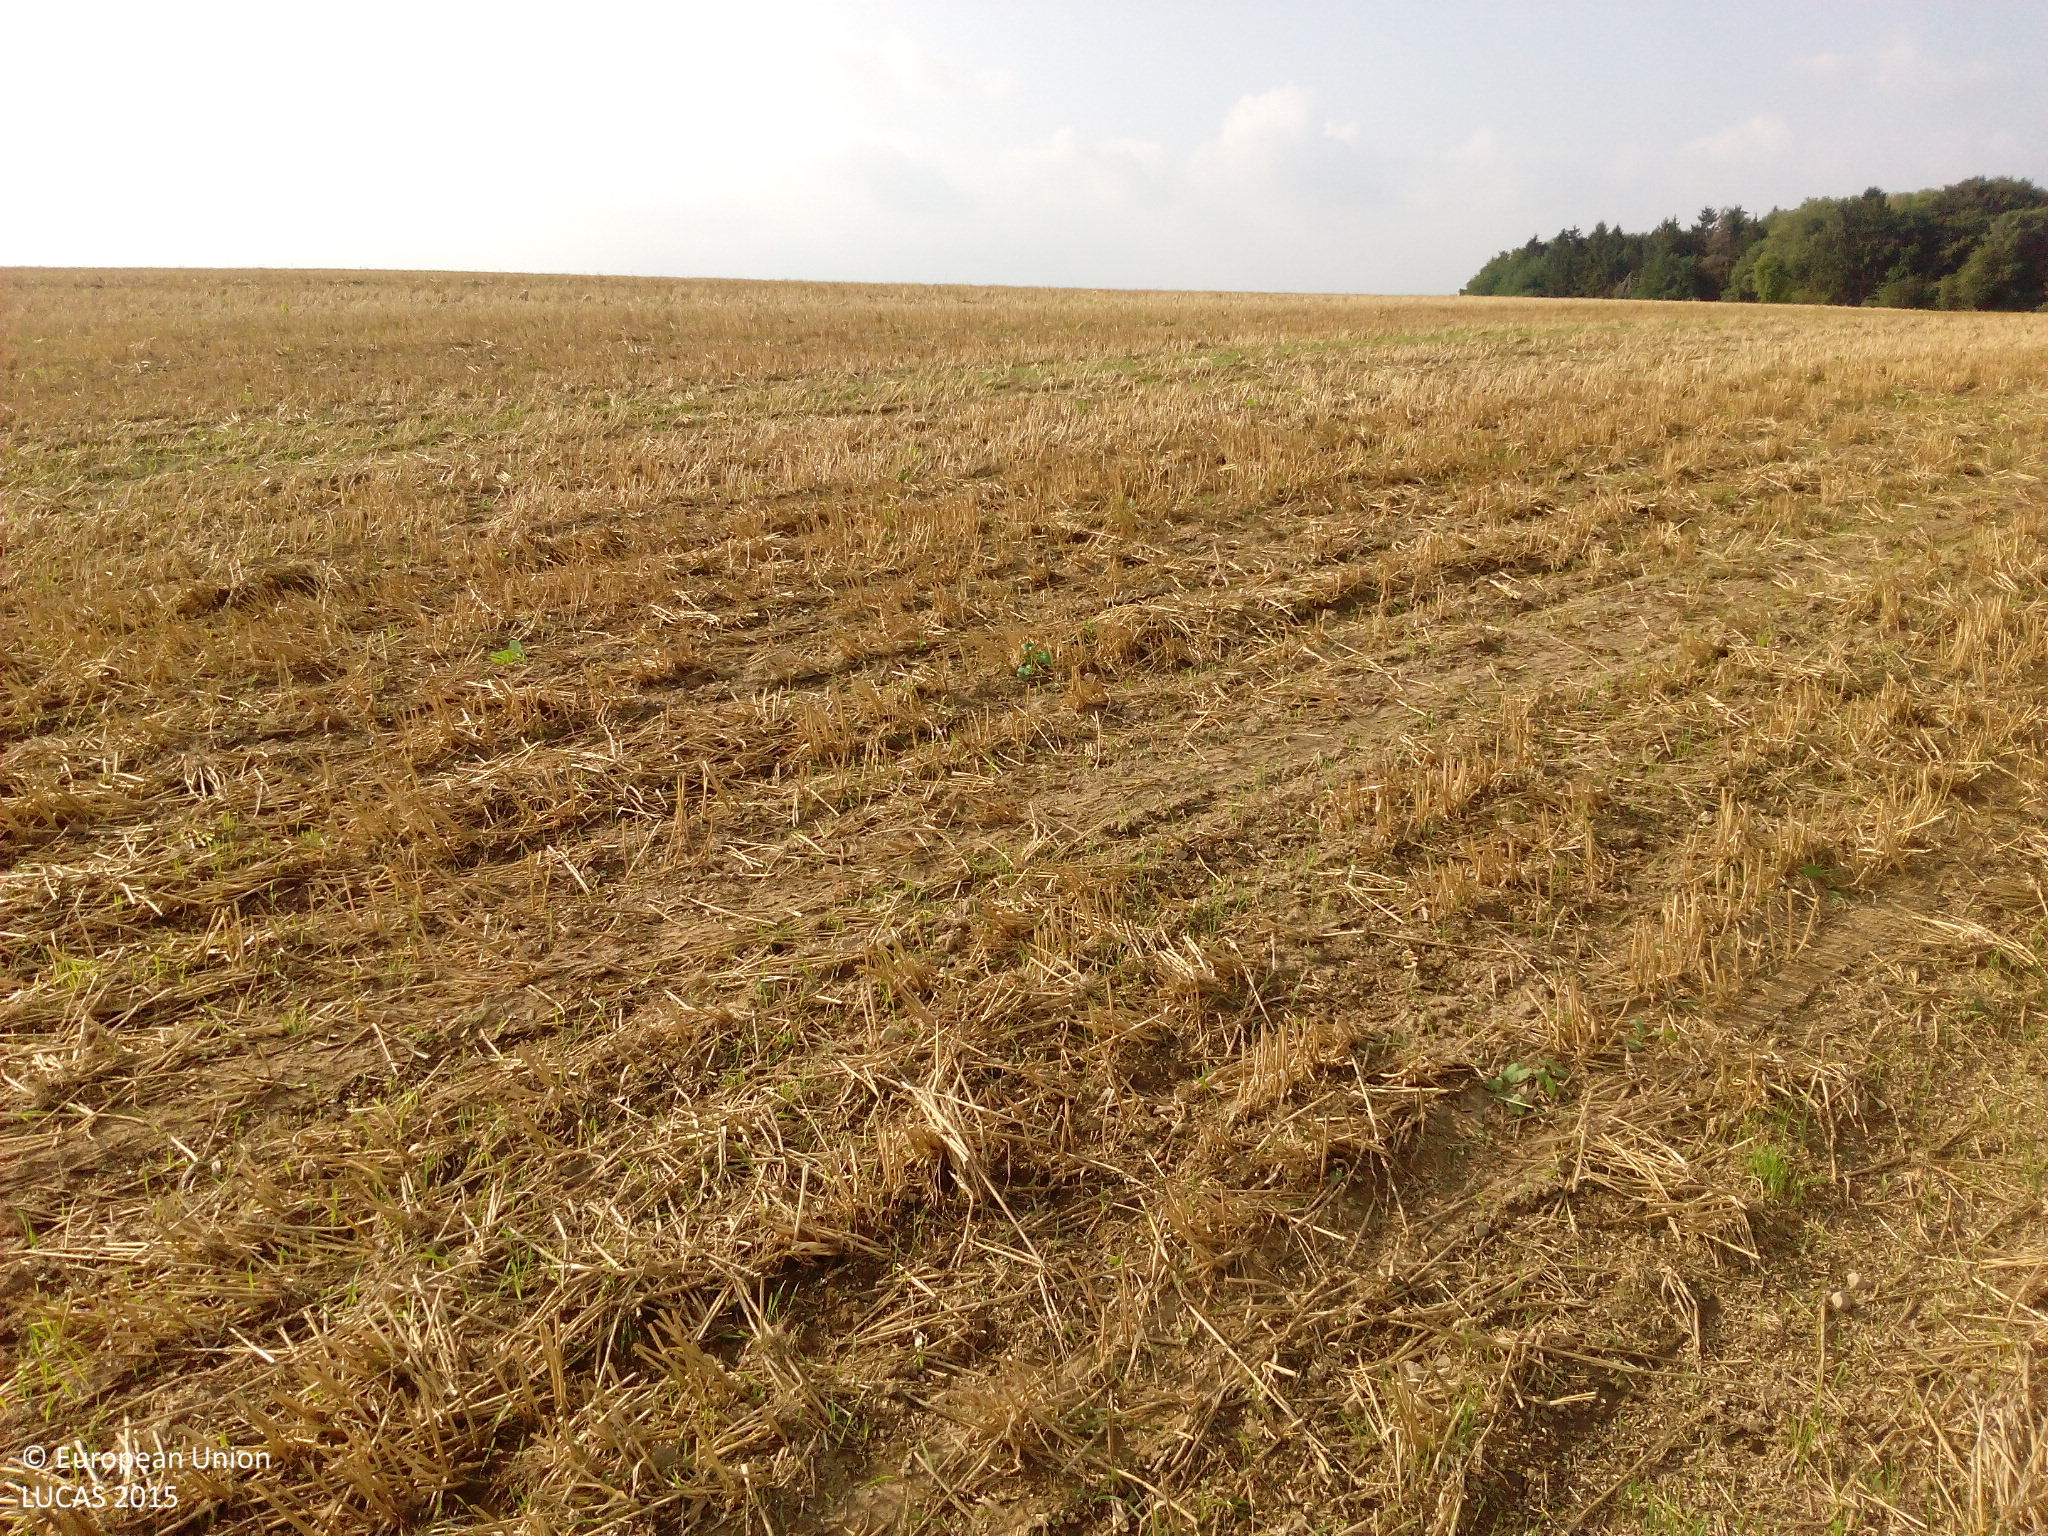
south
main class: Cropland
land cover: Common wheat
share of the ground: 50 - 75 %
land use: Agriculture (excluding fallow land and kitchen gardens)
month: September
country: DE
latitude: 54.1270
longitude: 12.7076
